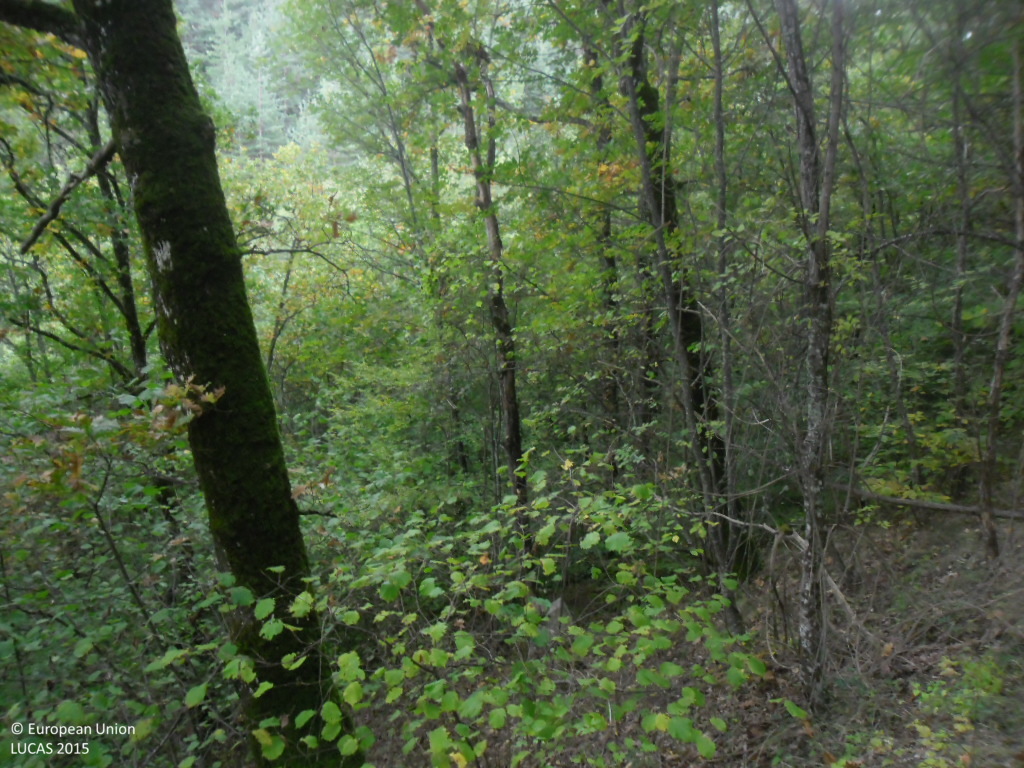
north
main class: Woodland
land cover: Broadleaved woodland
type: mountainous beech forest
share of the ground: > 75 %
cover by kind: broadleaved forest trees 95 %, unconsolidated bare surface 5 %
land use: Forestry
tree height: > 5 m
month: October
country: BG
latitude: 41.6534
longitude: 23.0970
